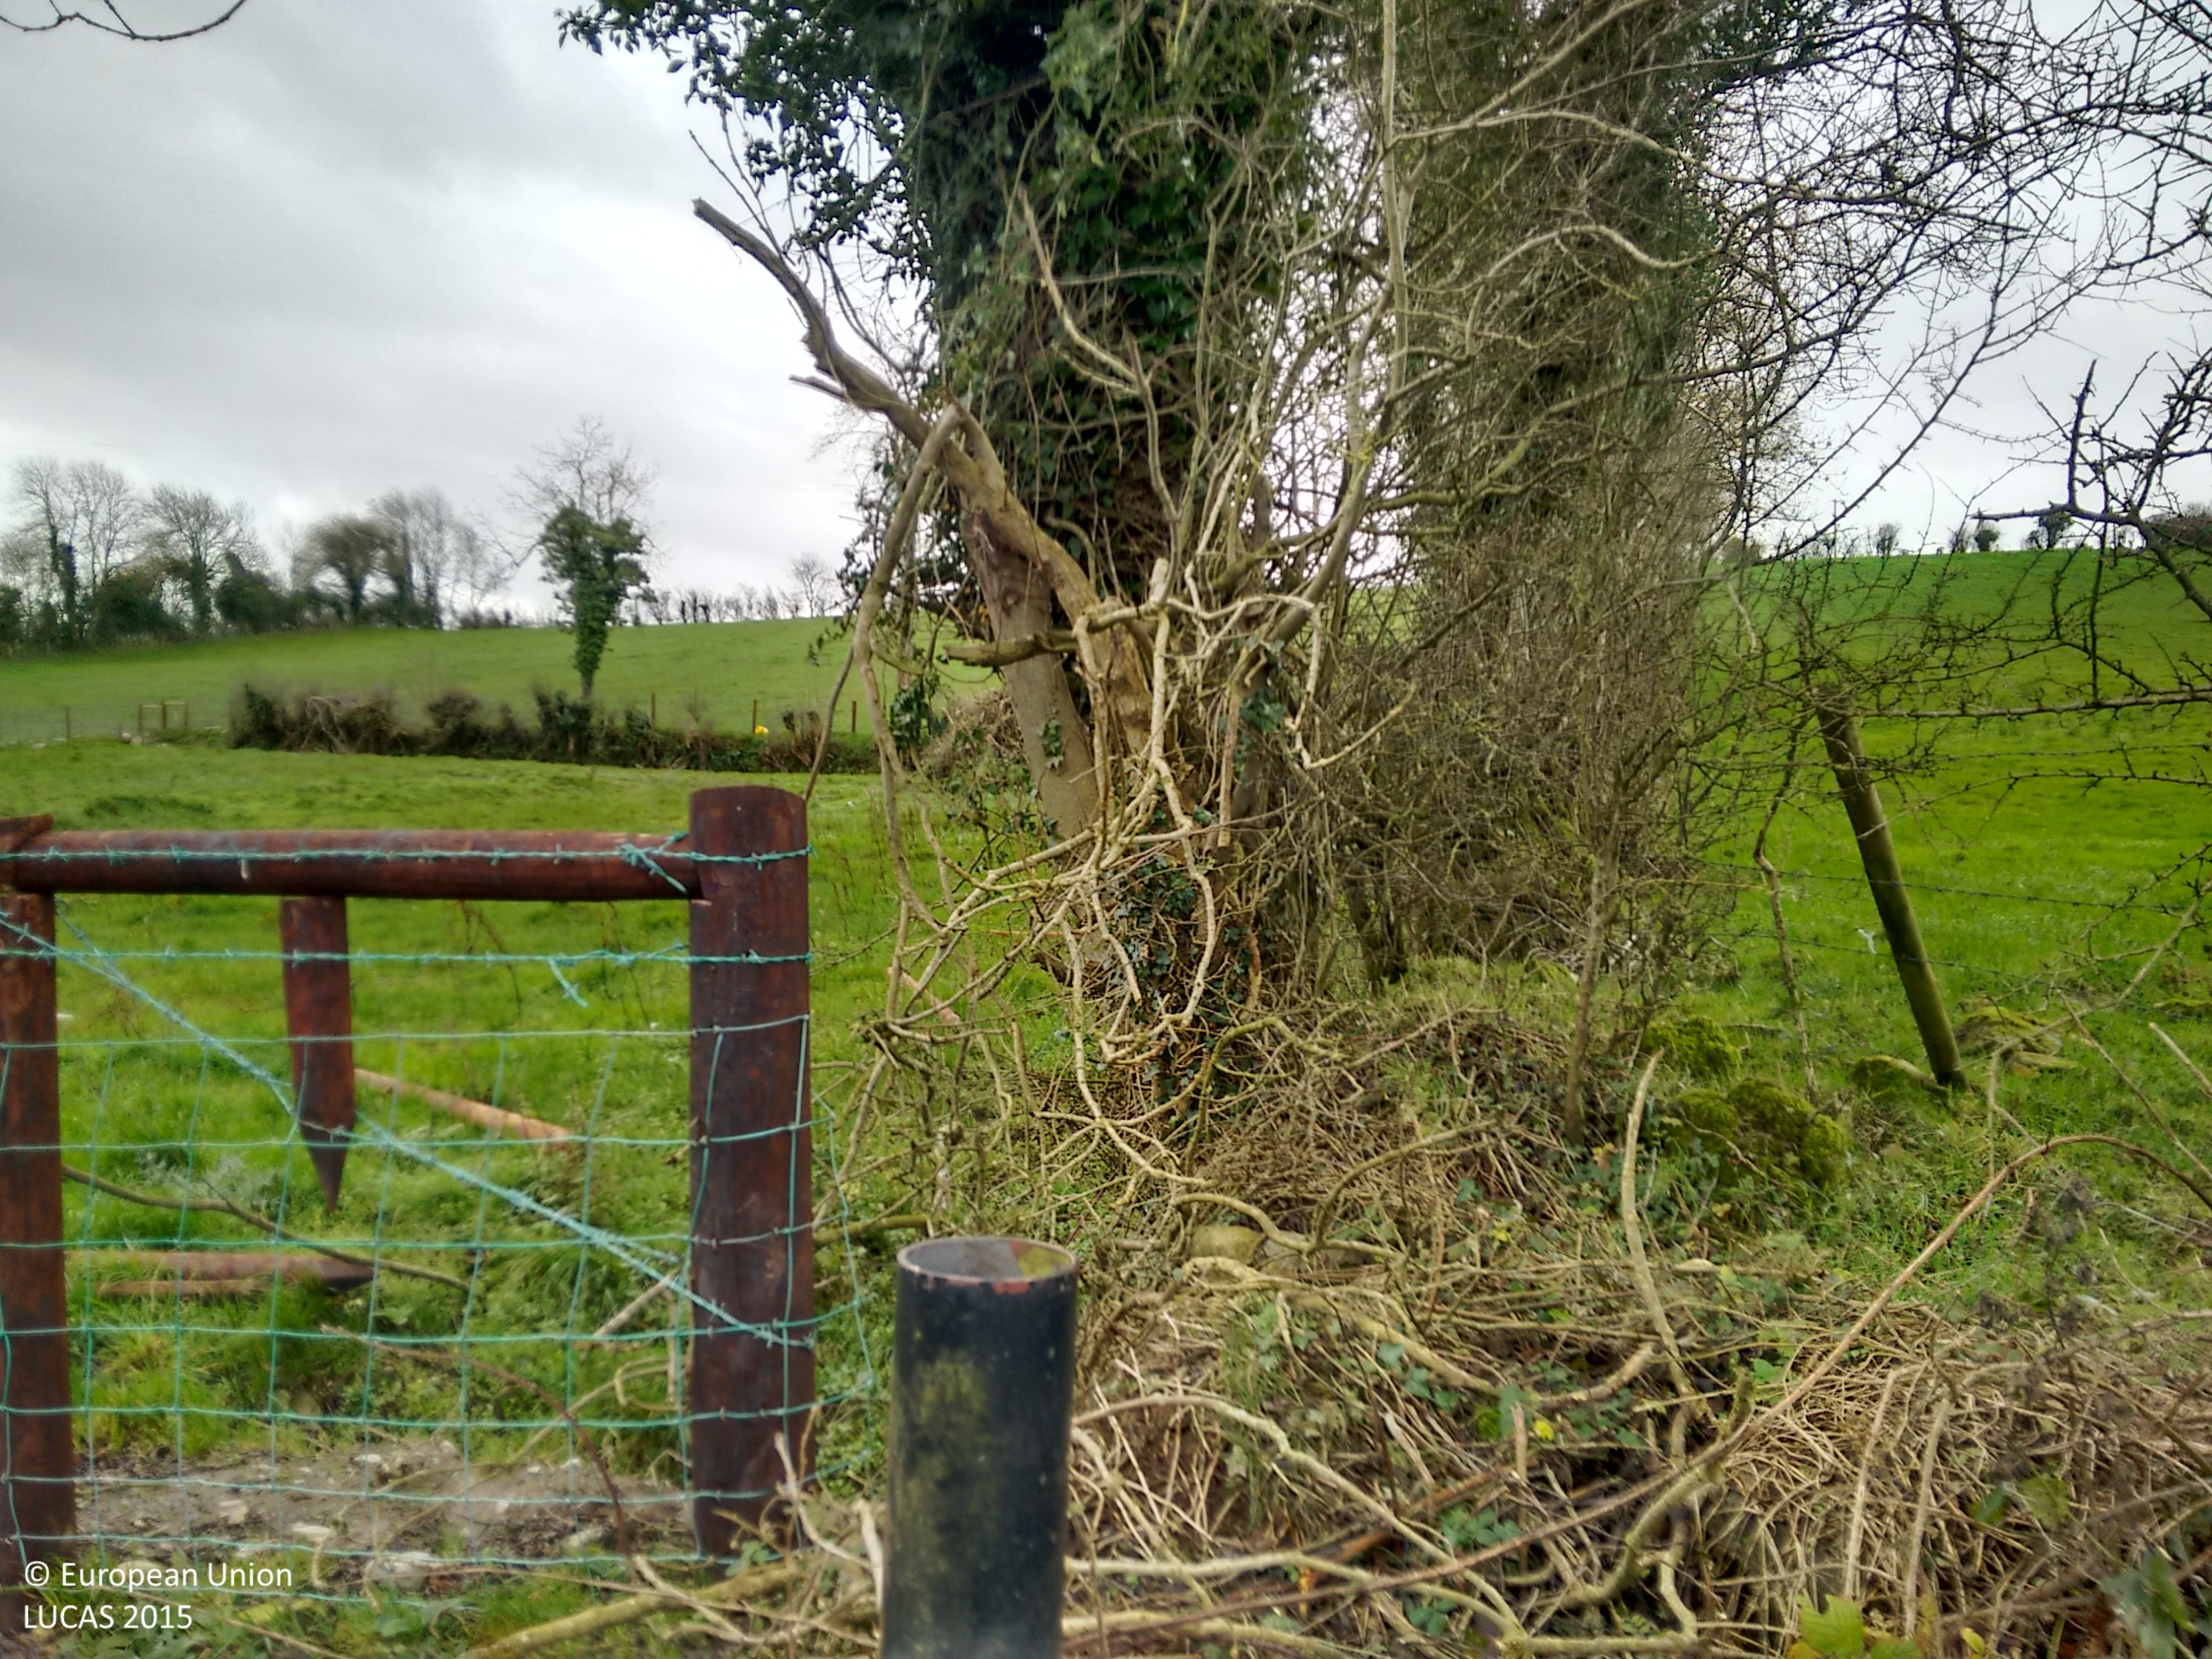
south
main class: Grassland
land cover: Grassland without tree/shrub cover
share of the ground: > 75 %
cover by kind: herbaceous plants 100 %
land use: Agriculture (excluding fallow land and kitchen gardens)
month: December
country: IE
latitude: 54.0992
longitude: -6.8817
